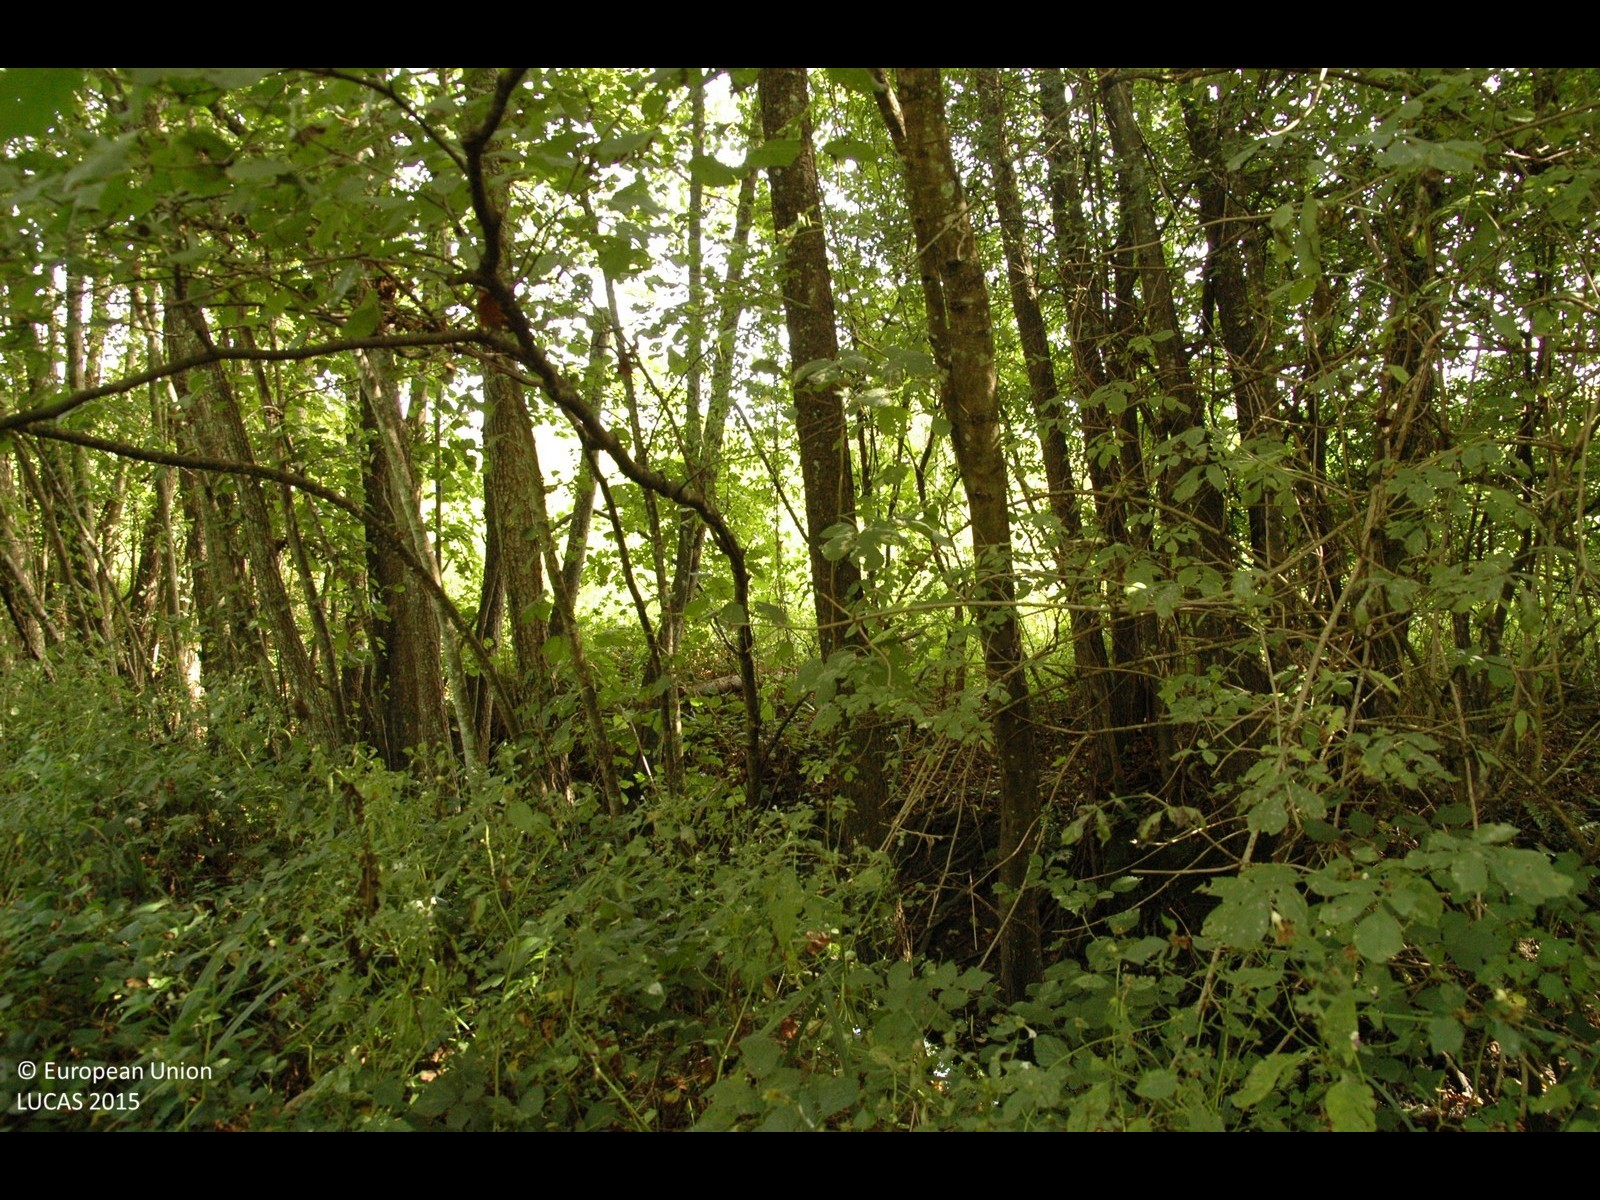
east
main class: Woodland
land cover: Broadleaved woodland
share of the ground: > 75 %
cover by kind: broadleaved forest trees 100 %
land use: Forestry
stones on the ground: < 10 %
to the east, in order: Broadleaved woodland; Rivers and streams; Broadleaved woodland; Shrubland with sparse tree cover; Electric lines; Shrubland with sparse tree cover; Grassland without tree/shrub cover; Shrubland with sparse tree cover; Tracks; Shrubland with sparse tree cover; Grassland without tree/shrub cover; Tracks; Grassland without tree/shrub cover; Shrubland with sparse tree cover; Other fruit trees and berries; Shrubland with sparse tree cover
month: September
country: HR
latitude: 45.5711
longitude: 15.9556
